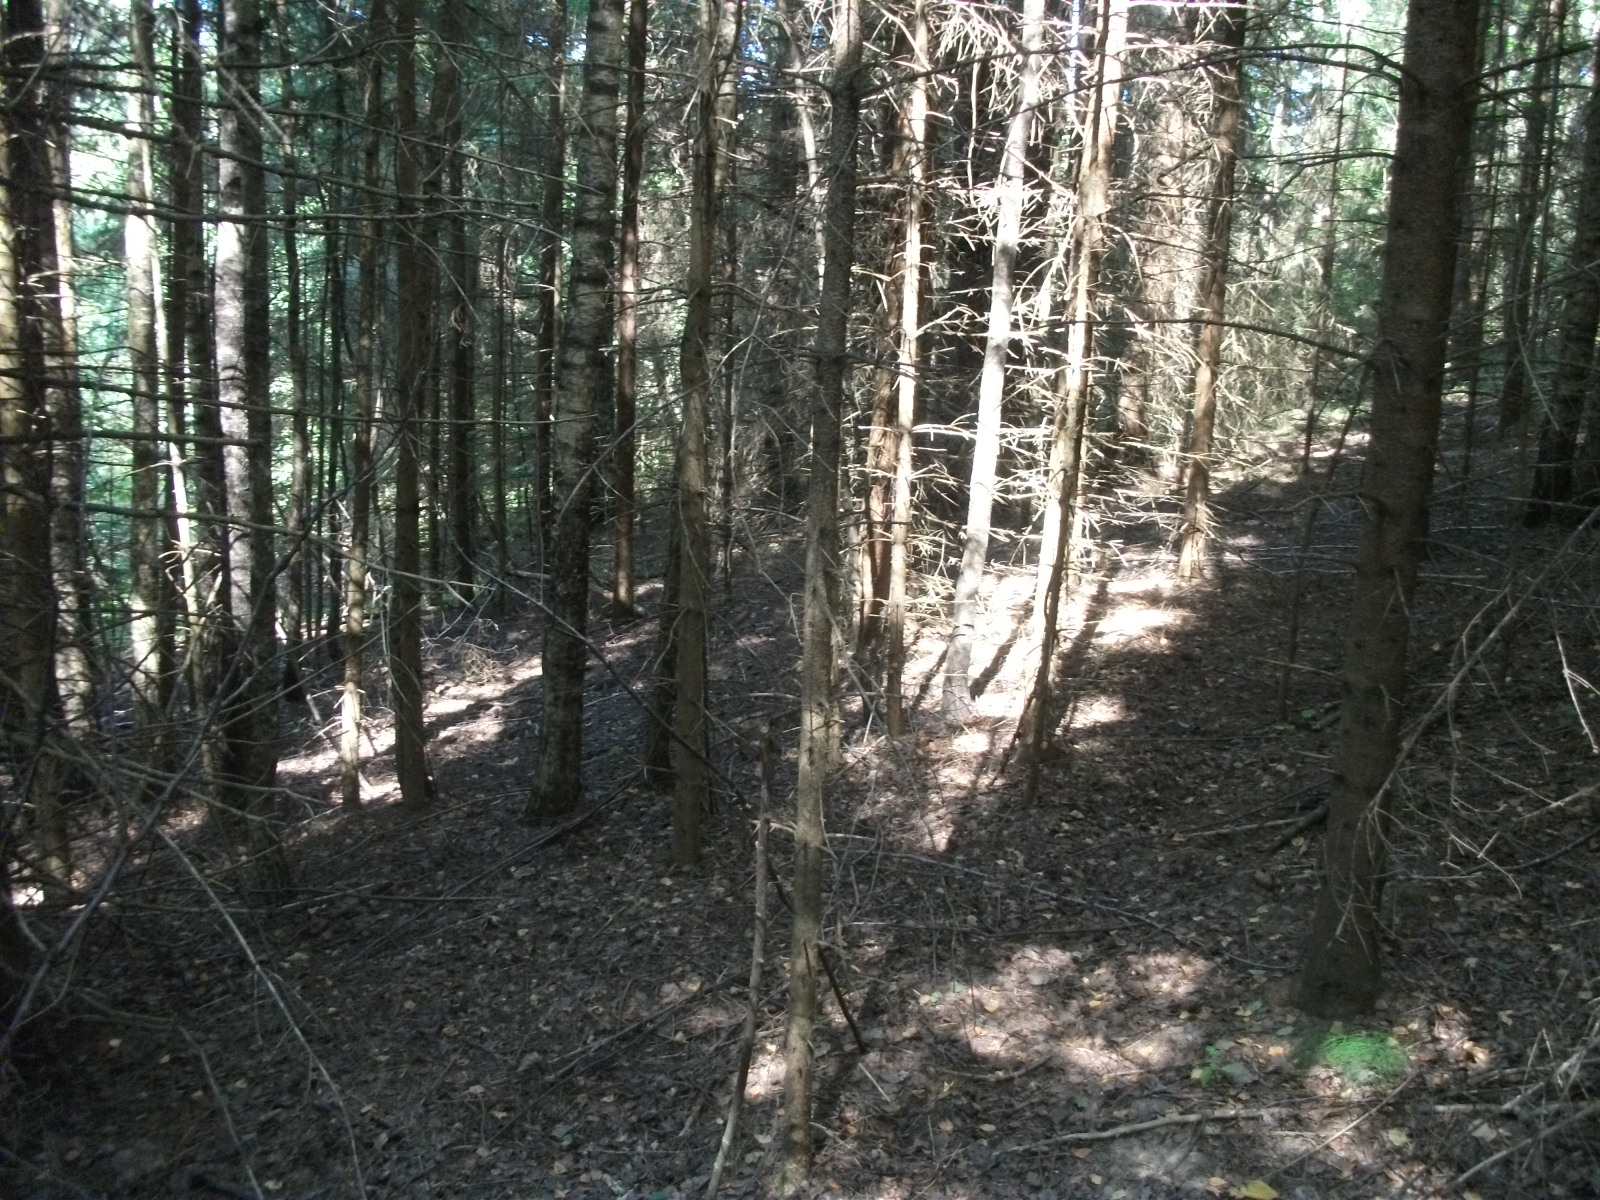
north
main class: Woodland
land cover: Spruce dominated coniferous woodland
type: hemiboreal forest and nemoral coniferous forest and mixed broadleaved-coniferous forest
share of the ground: > 75 %
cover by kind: coniferous forest trees 80 %, unconsolidated bare surface 10 %, broadleaved forest trees 5 %, herbaceous plants 5 %
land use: Forestry
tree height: > 5 m
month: August
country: LV
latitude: 56.5102
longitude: 26.0432
